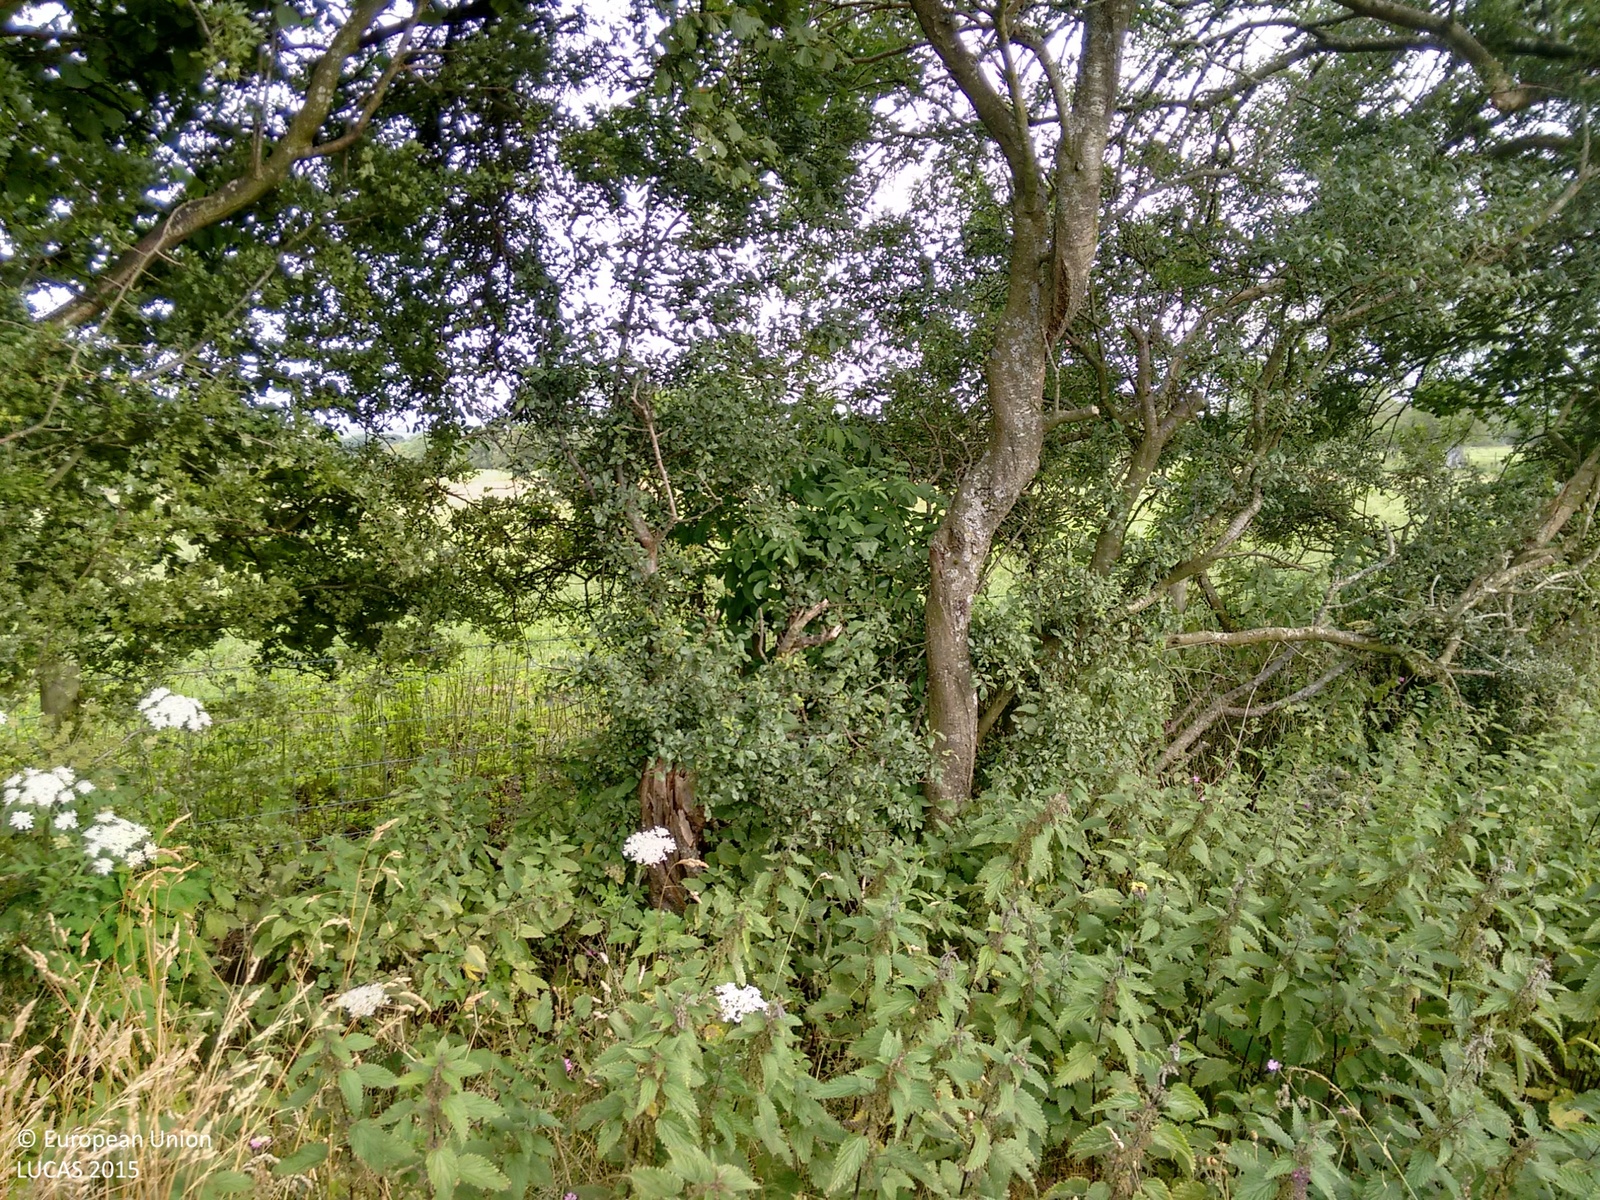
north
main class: Grassland
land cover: Grassland without tree/shrub cover
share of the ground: > 75 %
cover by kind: herbaceous plants 100 %
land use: Agriculture (excluding fallow land and kitchen gardens)
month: August
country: GB
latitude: 54.7160
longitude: -3.3827
